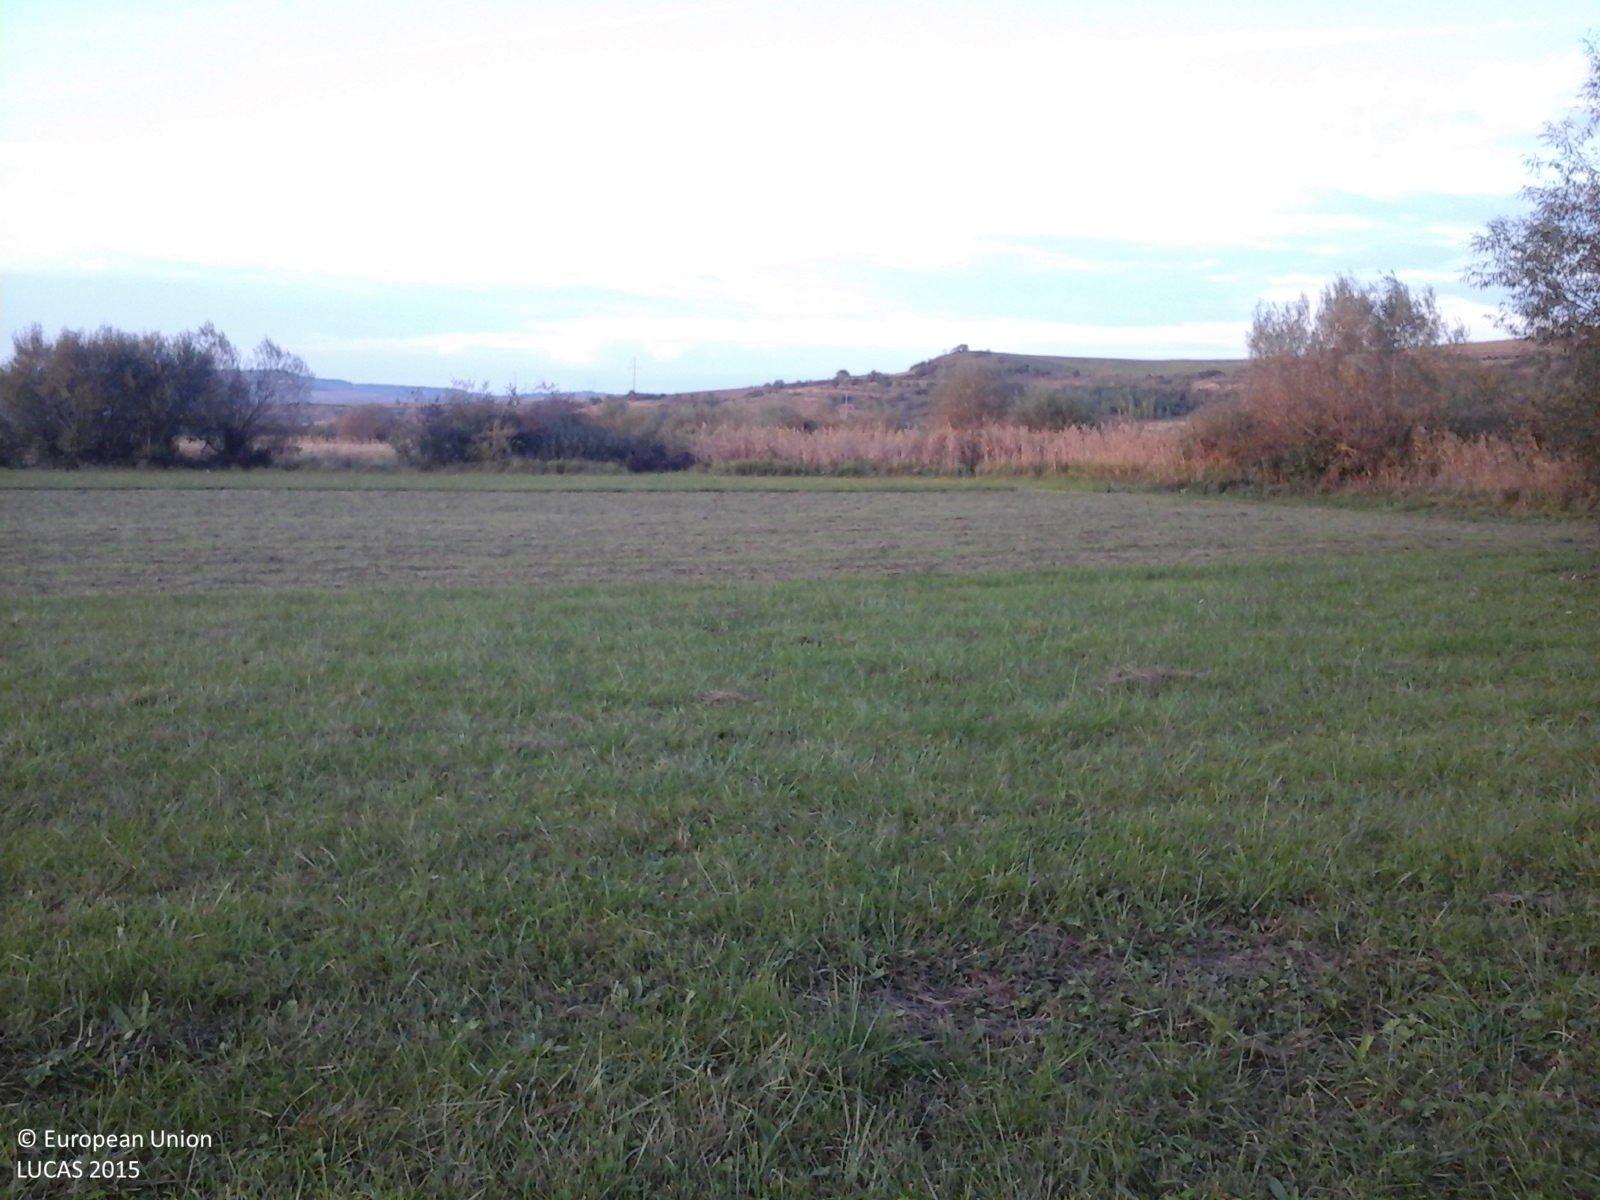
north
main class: Grassland
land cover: Grassland without tree/shrub cover
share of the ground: > 75 %
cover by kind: herbaceous plants 100 %
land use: Agriculture (excluding fallow land and kitchen gardens)
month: October
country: RO
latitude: 46.2845
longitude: 24.2667
